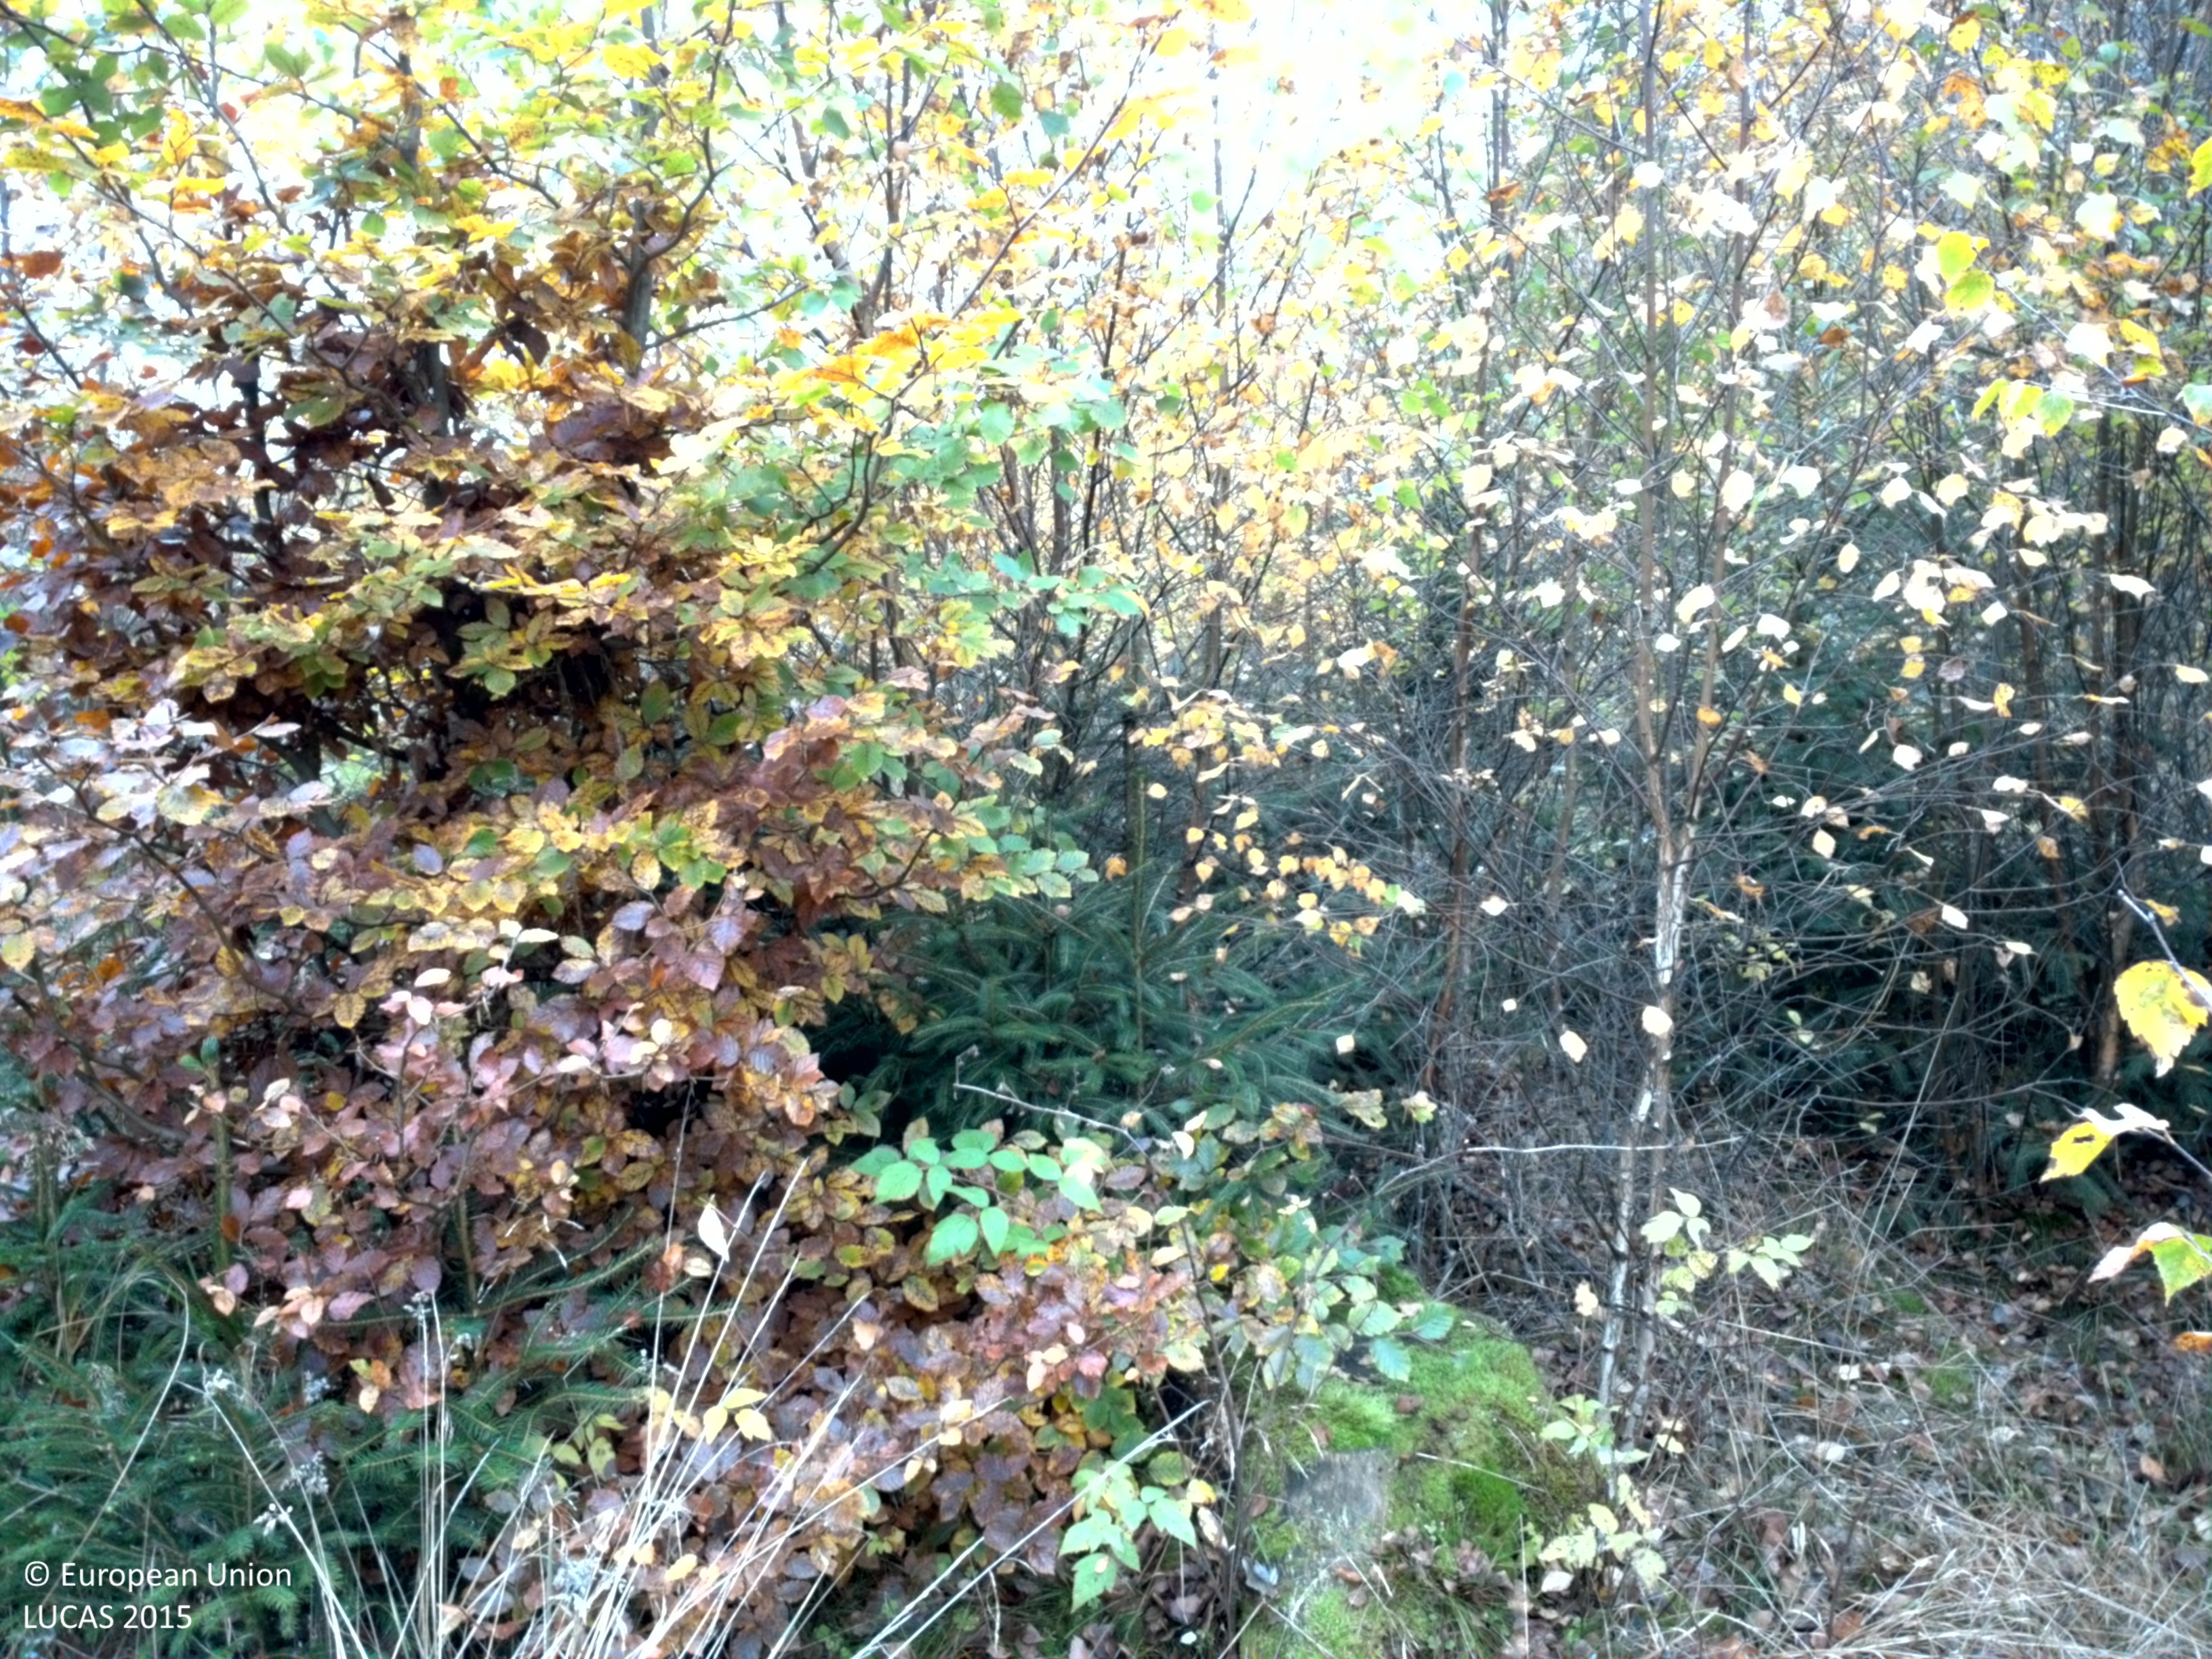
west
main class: Woodland
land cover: Other mixed woodland
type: hemiboreal forest and nemoral coniferous forest and mixed broadleaved-coniferous forest
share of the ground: 50 - 75 %
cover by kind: broadleaved forest trees 50 %, herbaceous plants 25 %, coniferous forest trees 20 %, shrubs 5 %
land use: Forestry
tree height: < 5 m
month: October
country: SE
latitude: 55.9367
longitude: 13.6958
